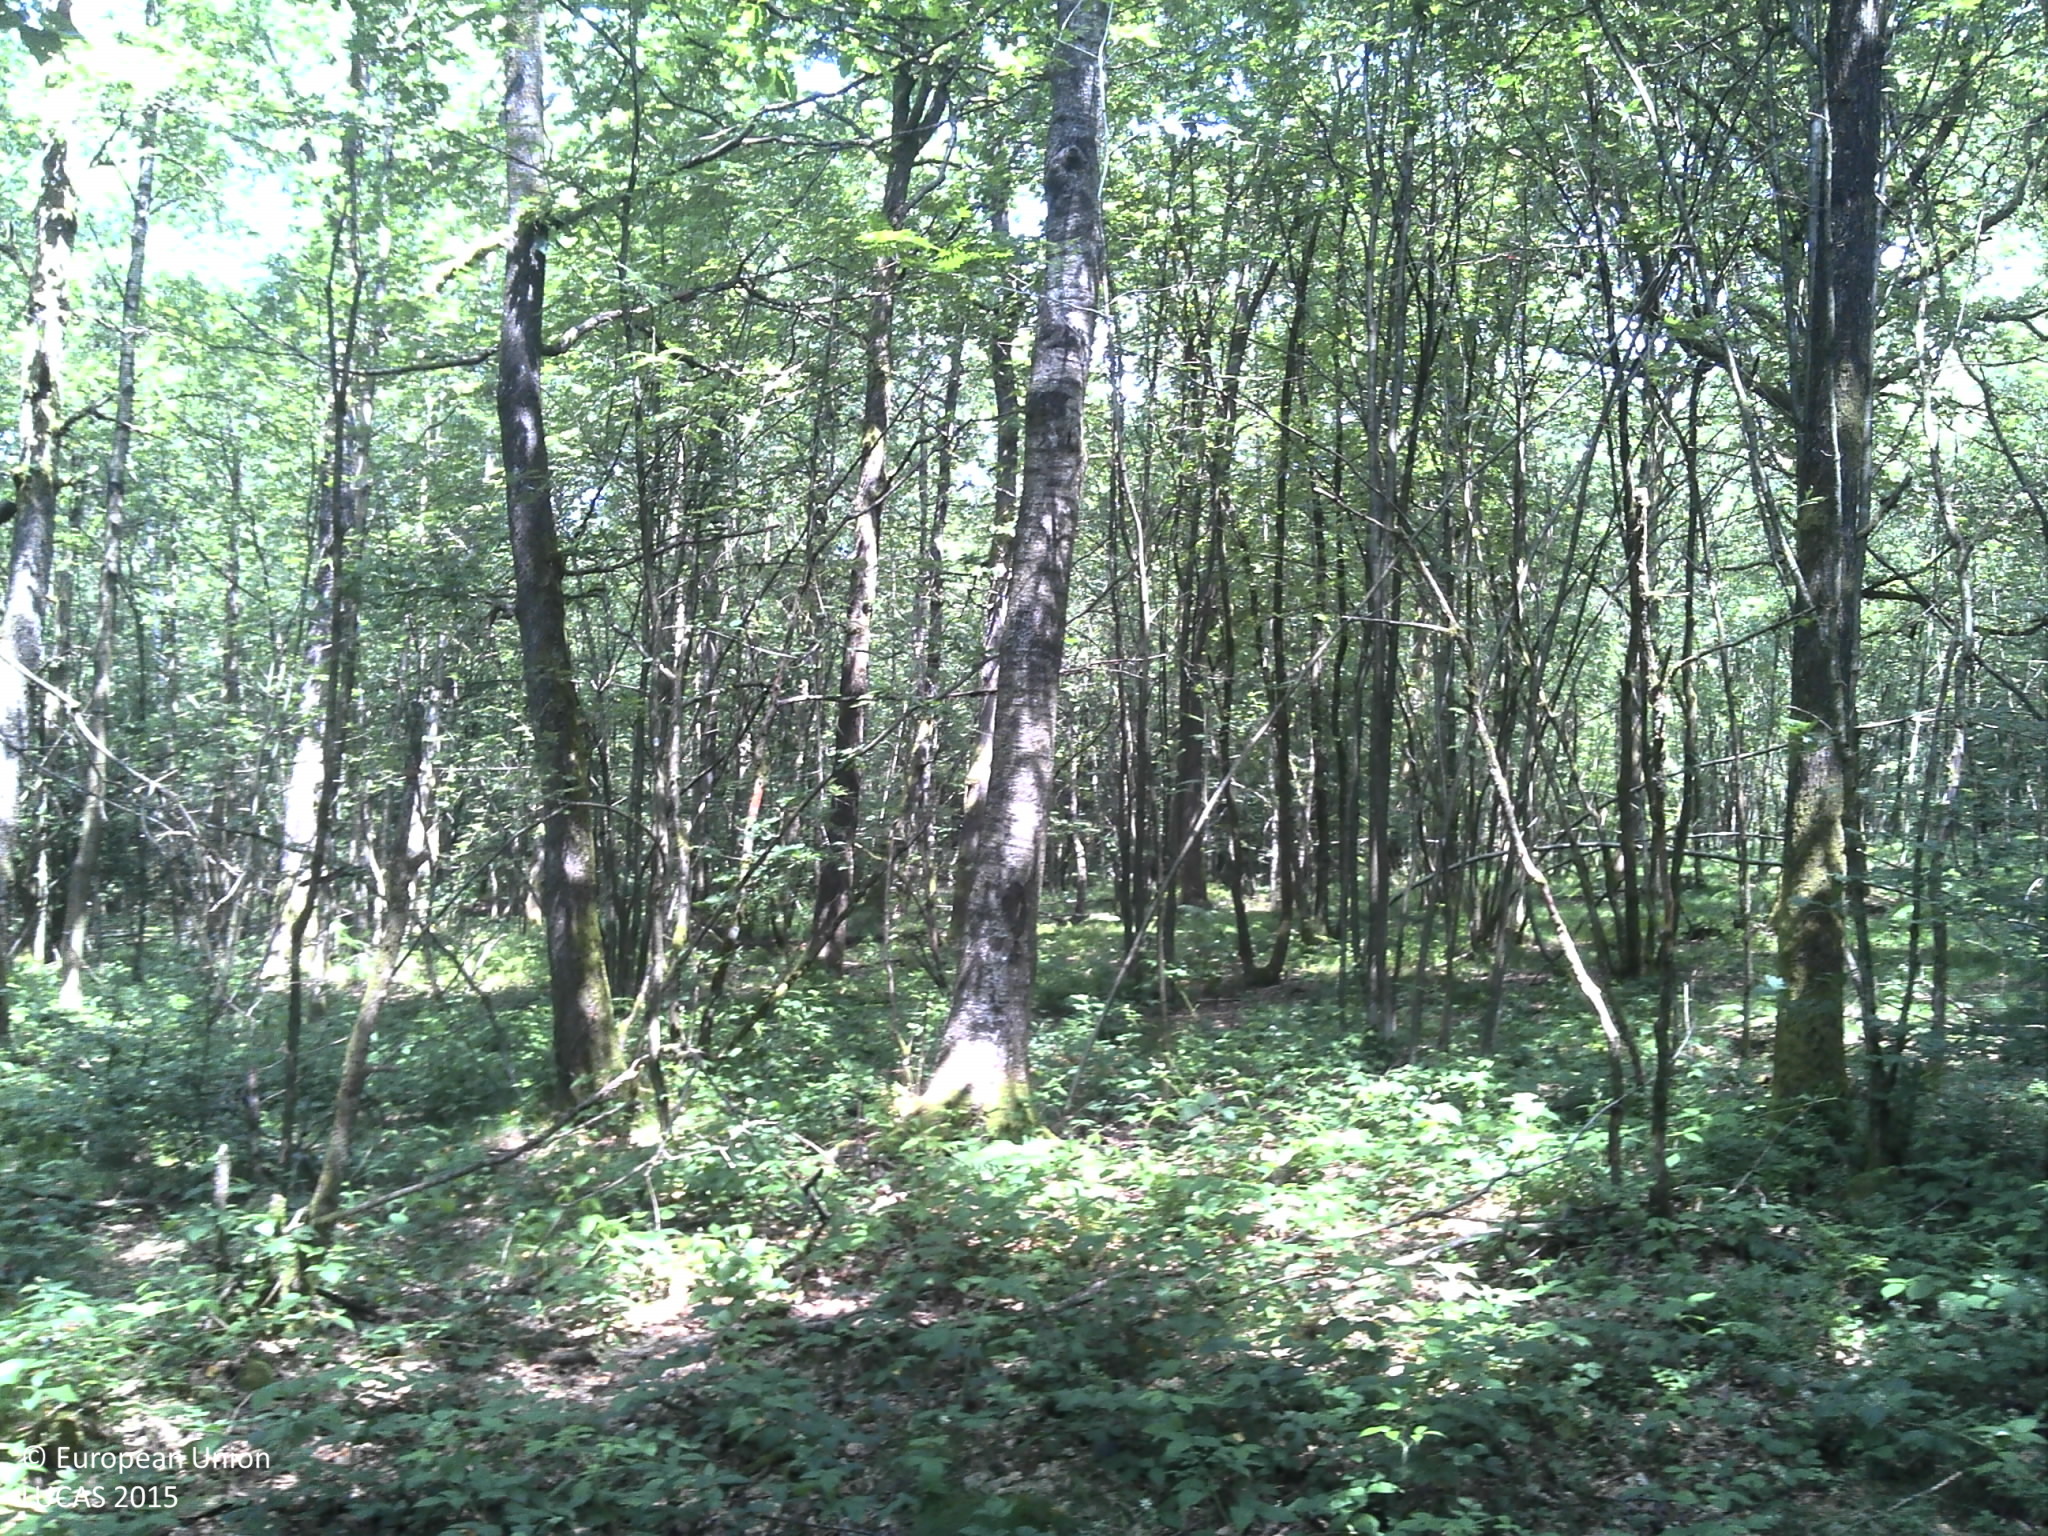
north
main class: Woodland
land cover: Broadleaved woodland
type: acidophilous oak and oak-birch forest
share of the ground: 50 - 75 %
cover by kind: broadleaved forest trees 70 %, herbaceous plants 25 %, consolidated bare surface 5 %
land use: Forestry
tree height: > 5 m
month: July
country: FR
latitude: 49.9203
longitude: 4.7738
